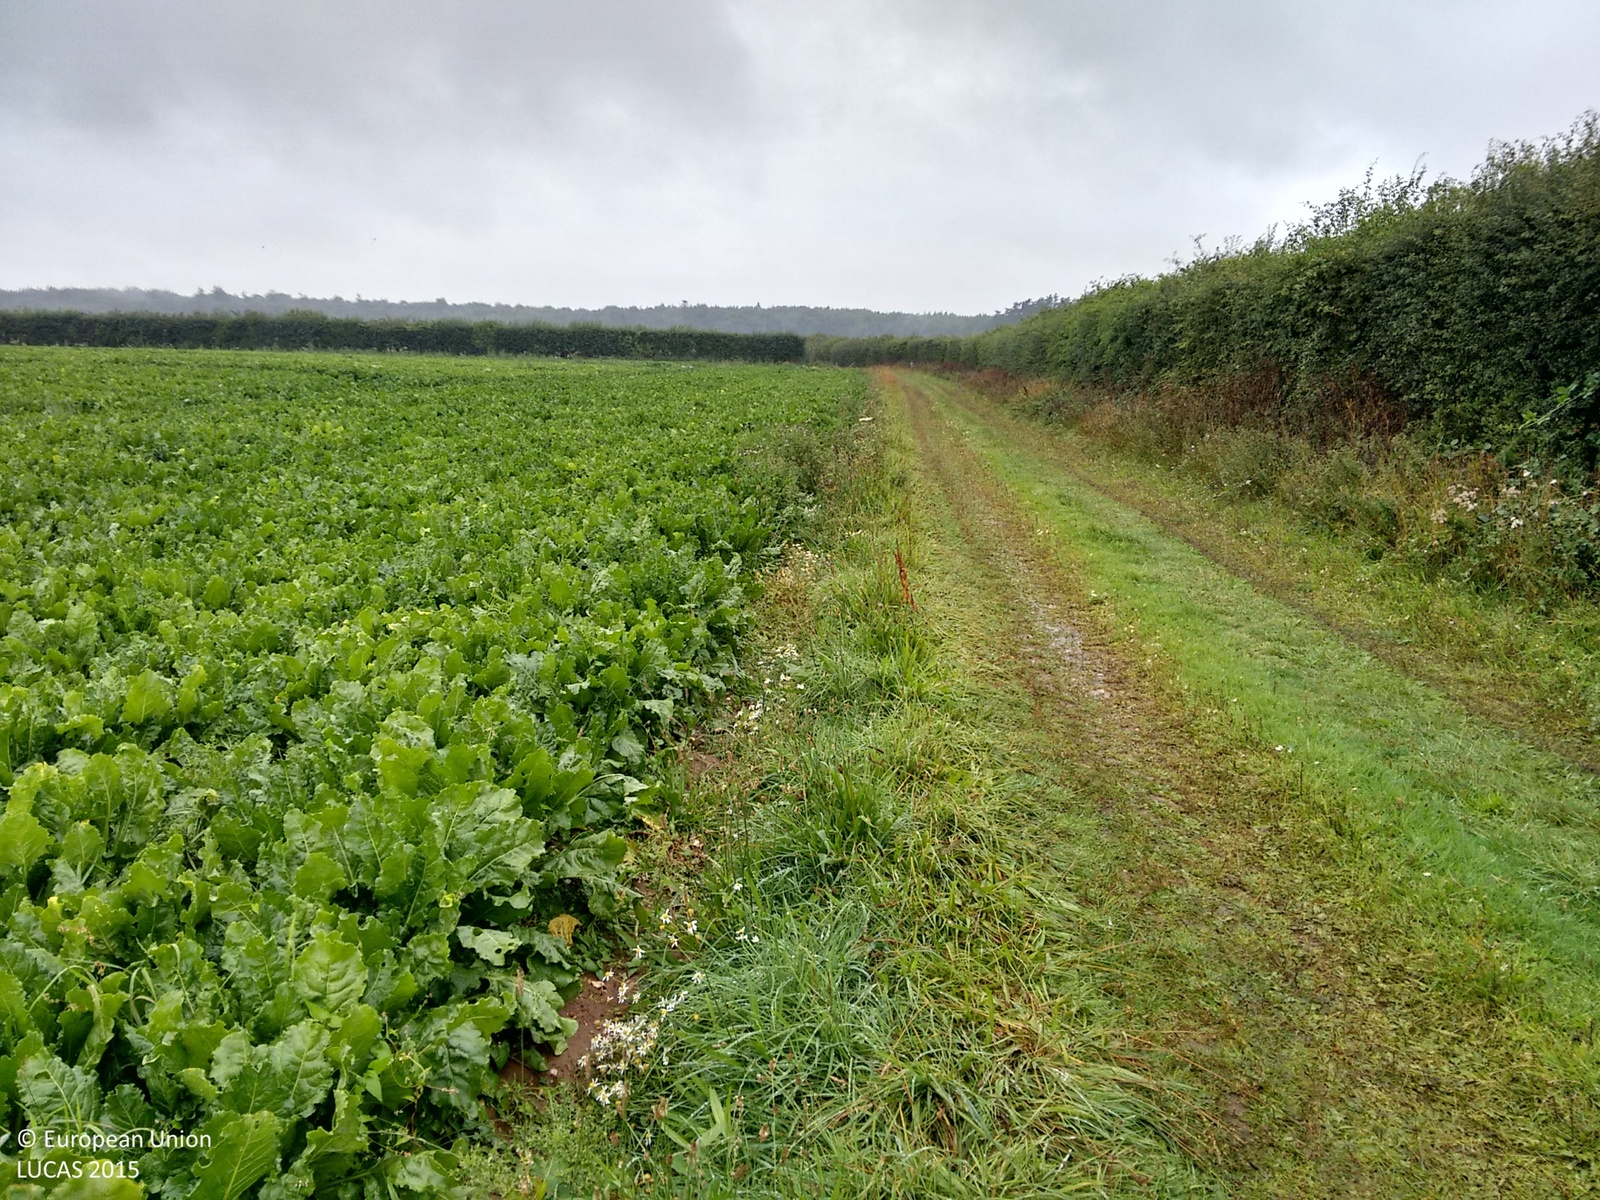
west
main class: Cropland
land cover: Sugar beet
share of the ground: > 75 %
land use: Agriculture (excluding fallow land and kitchen gardens)
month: August
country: GB
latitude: 52.9065
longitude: 0.8017
